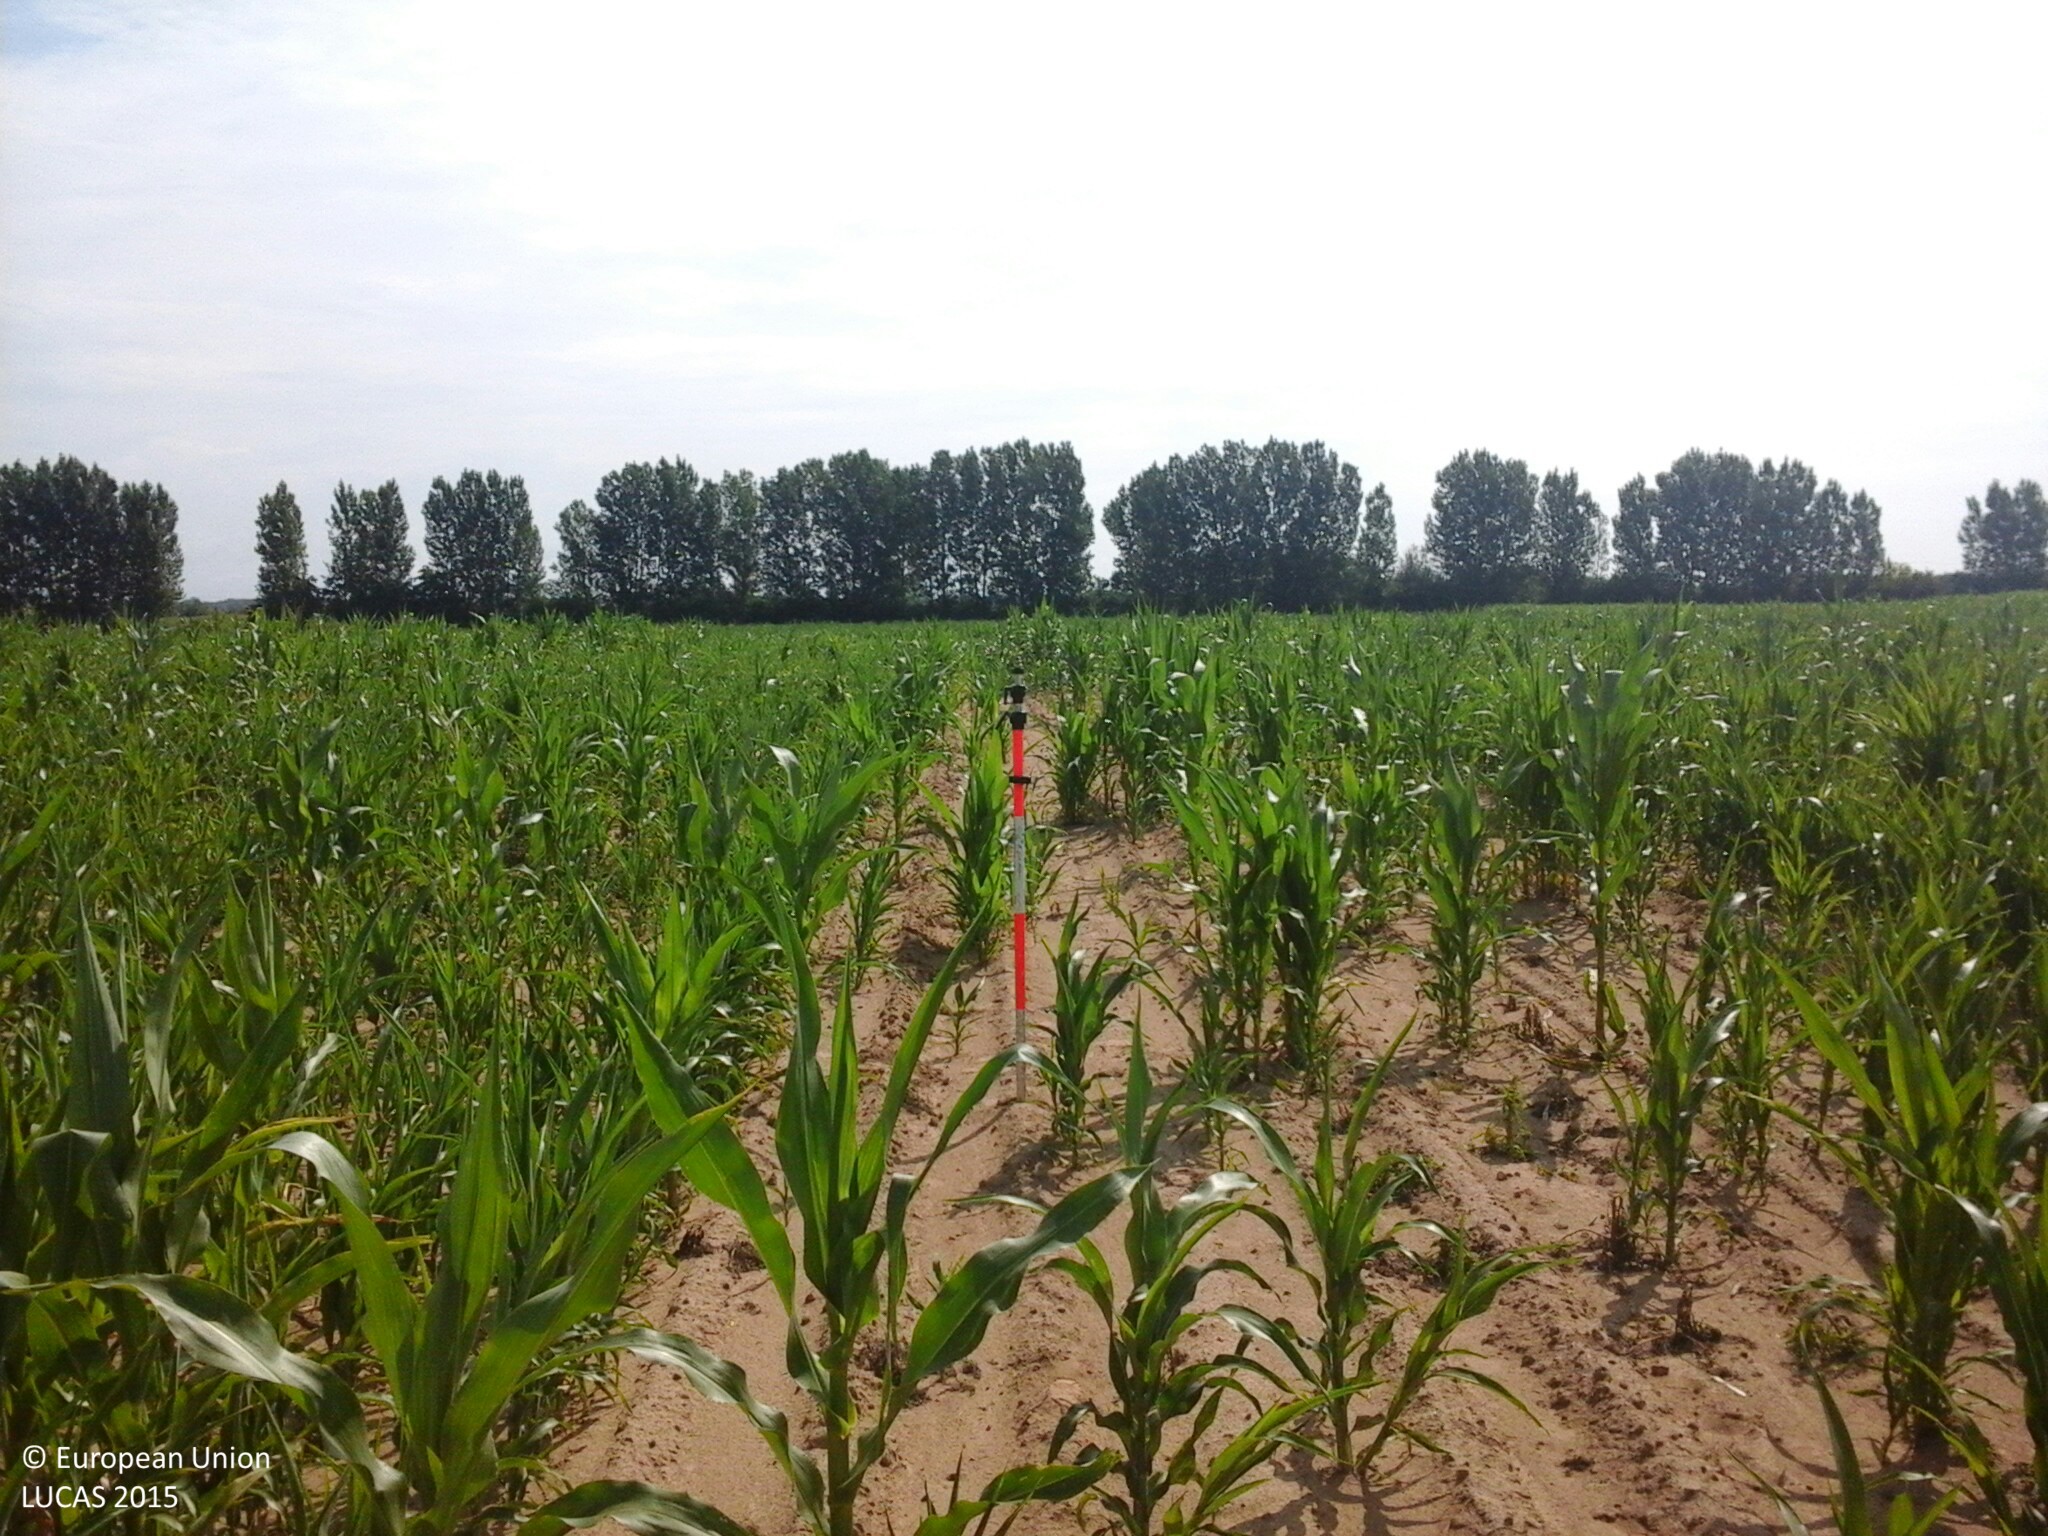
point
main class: Cropland
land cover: Maize
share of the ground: 50 - 75 %
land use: Agriculture (excluding fallow land and kitchen gardens)
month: July
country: HU
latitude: 48.3983
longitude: 22.1992
